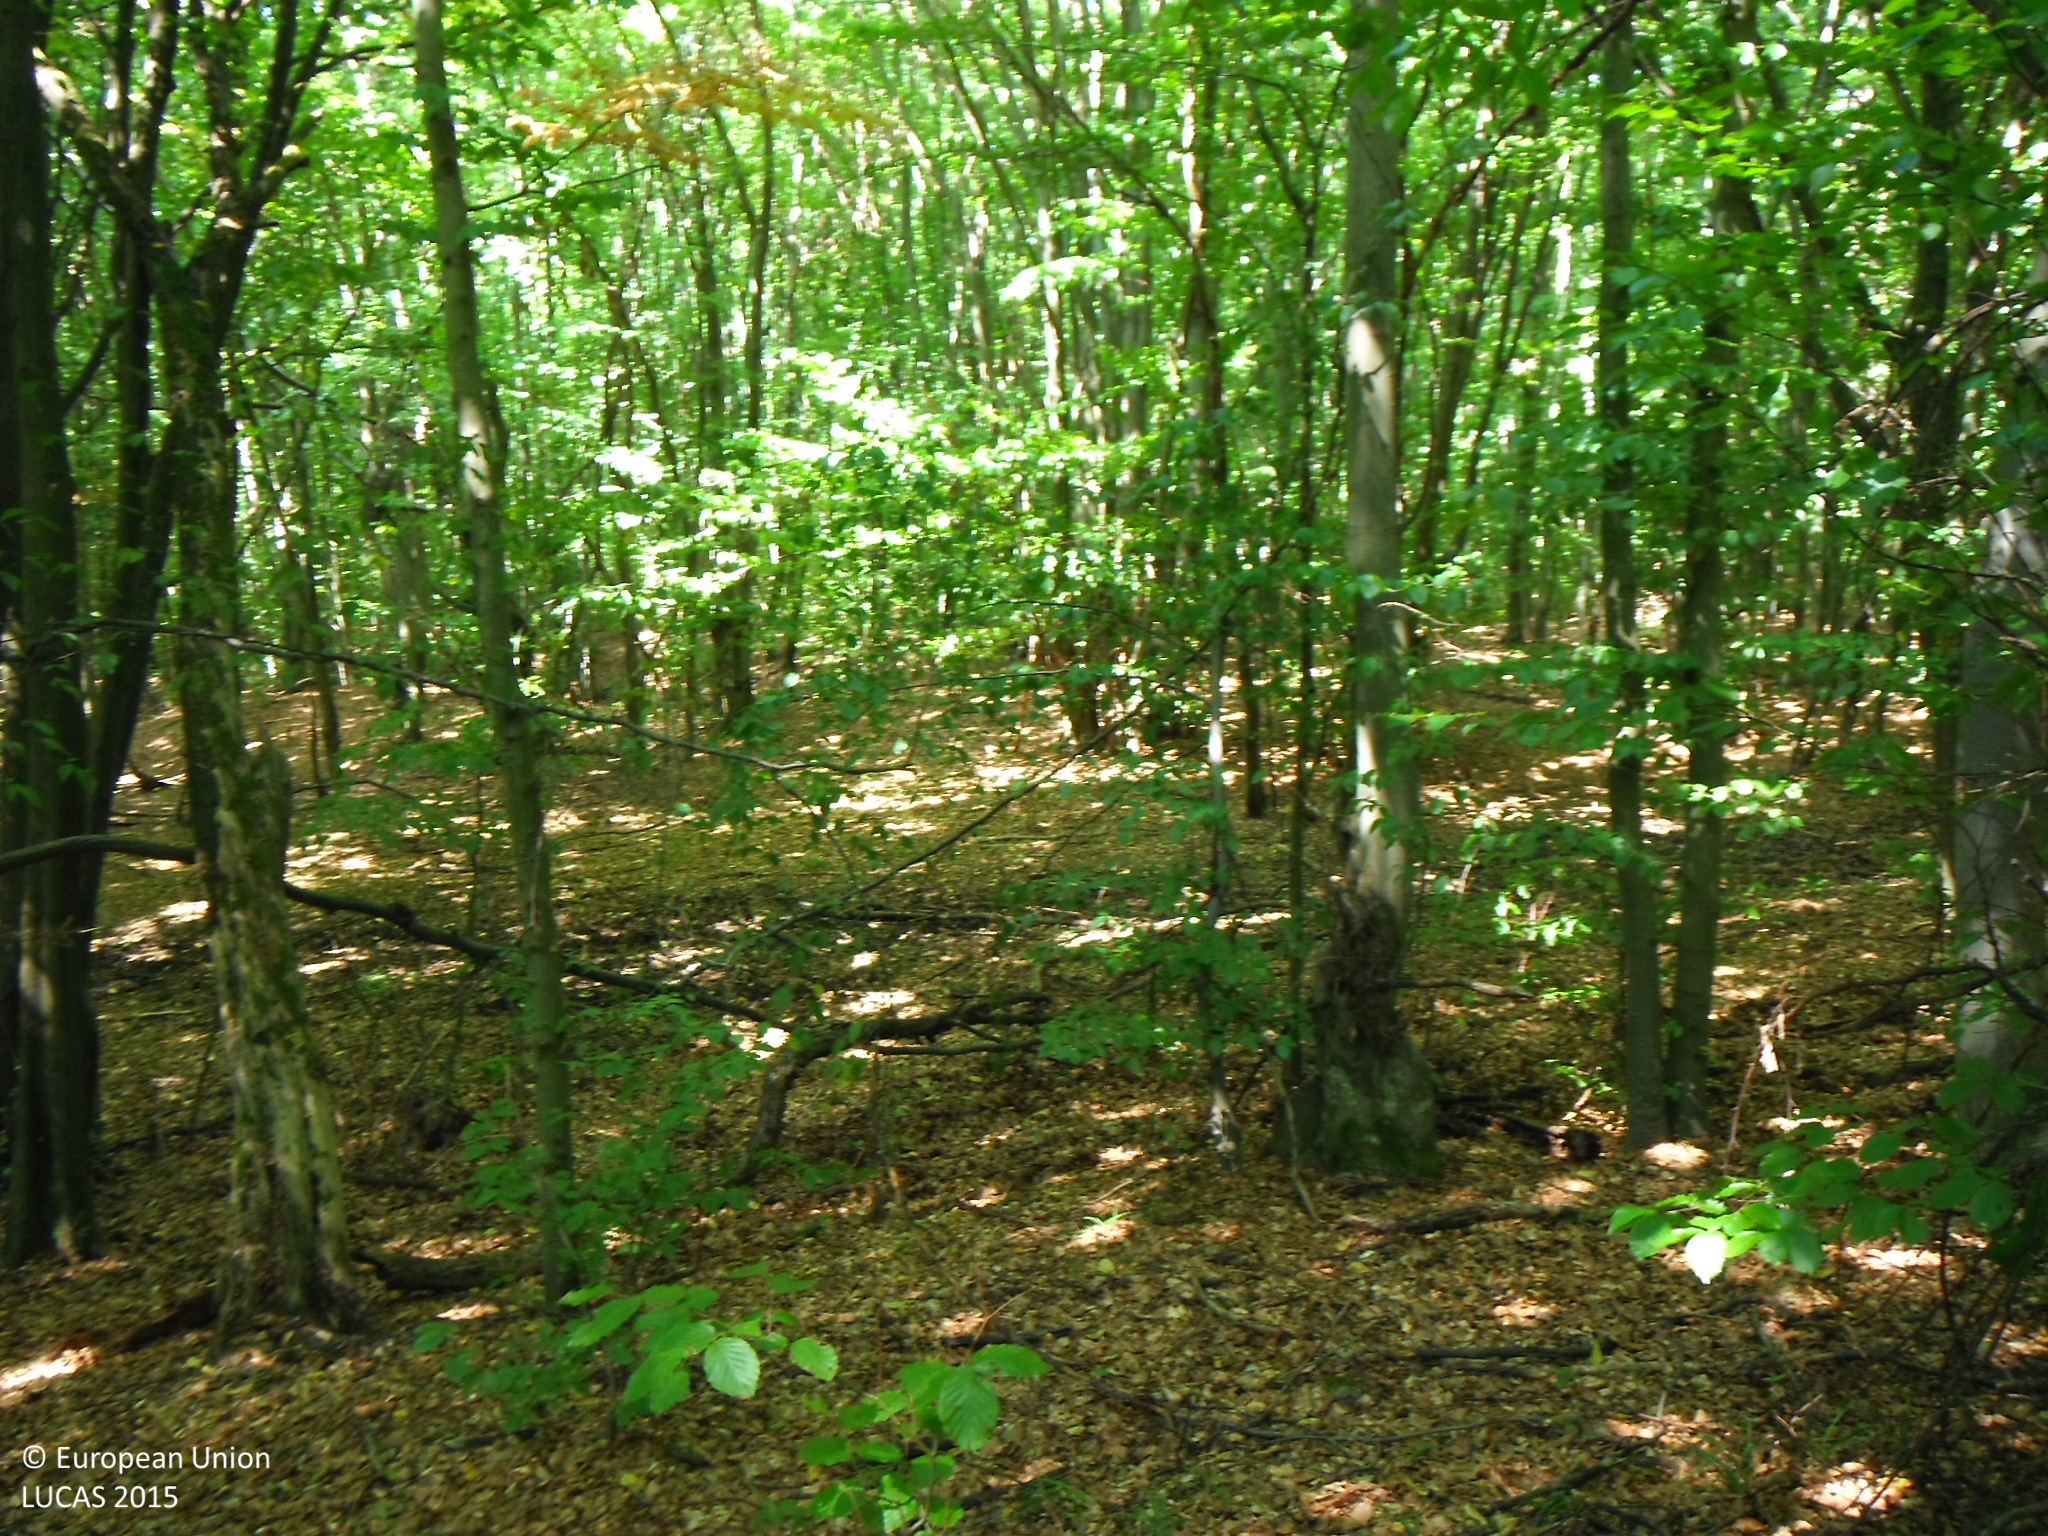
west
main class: Woodland
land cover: Broadleaved woodland
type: mesophytic deciduous forest
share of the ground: > 75 %
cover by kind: broadleaved forest trees 100 %
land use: Forestry
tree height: > 5 m
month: August
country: SK
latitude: 49.1509
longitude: 21.9698
